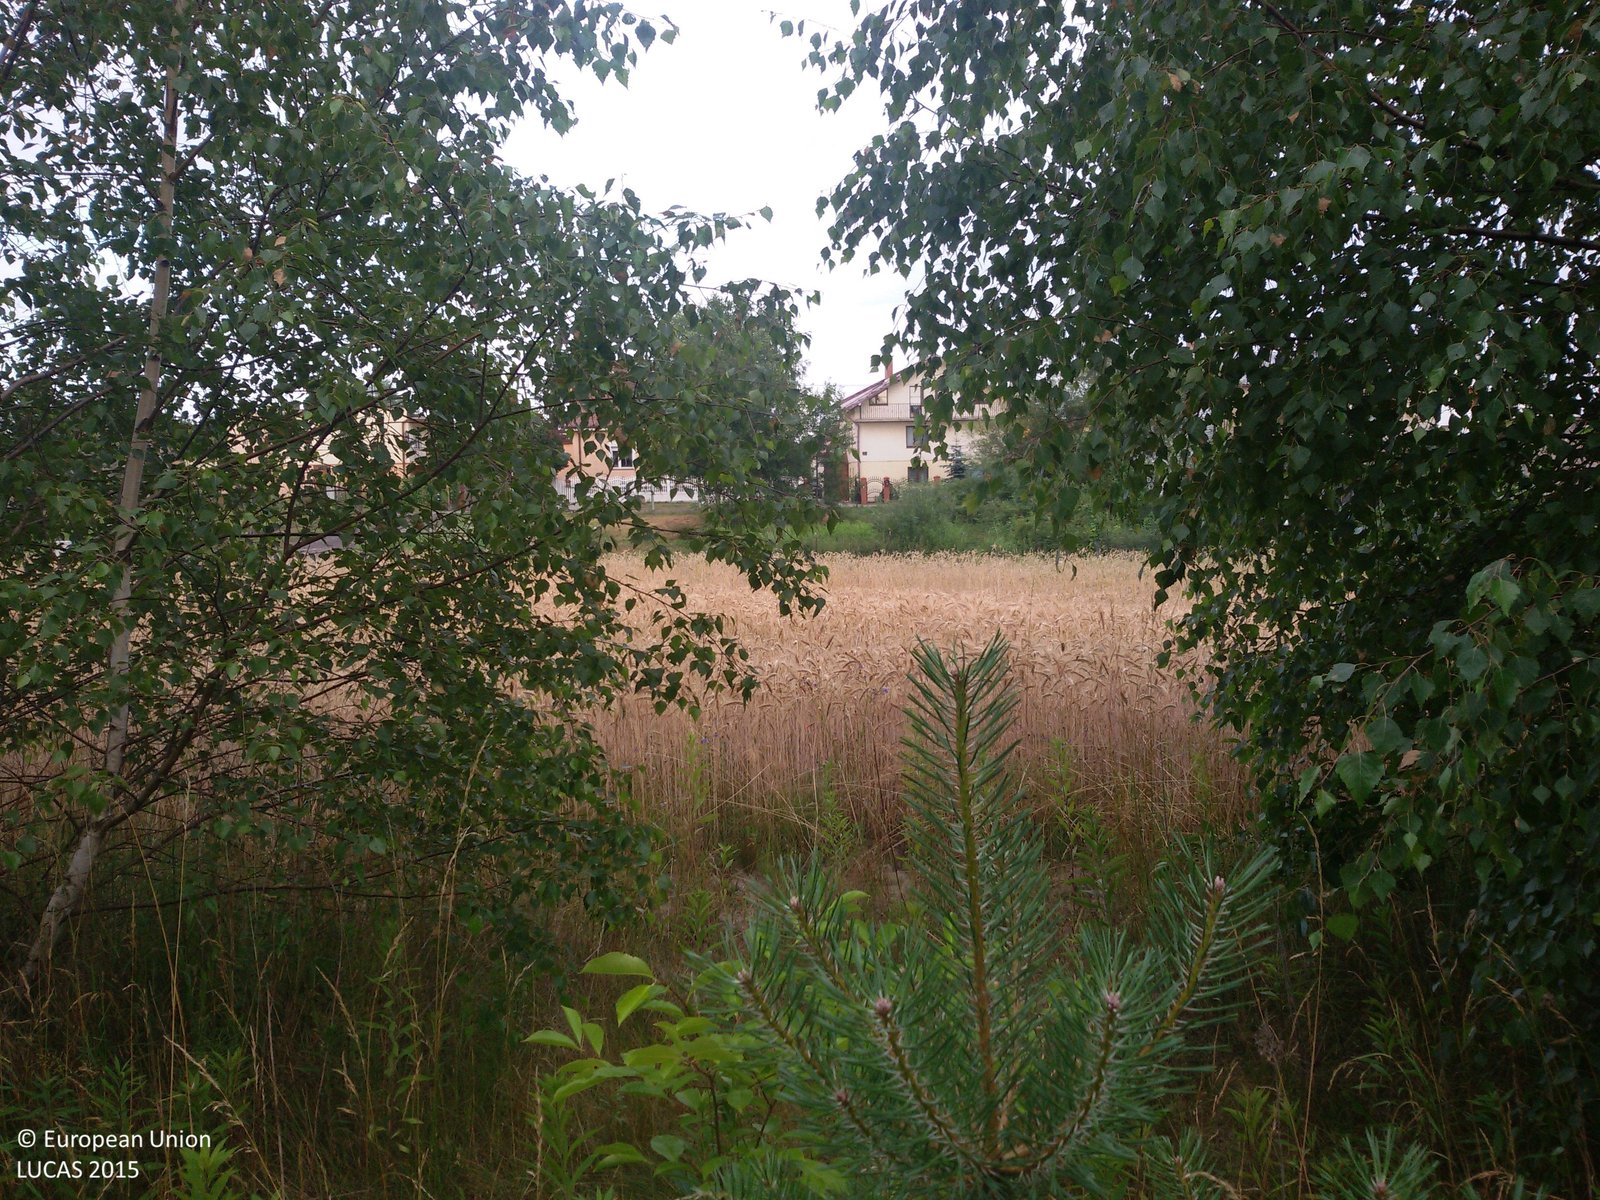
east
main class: Woodland
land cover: Broadleaved woodland
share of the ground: 10 - 25 %
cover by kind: herbaceous plants 85 %, broadleaved forest trees 15 %
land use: Semi-natural and natural areas not in use
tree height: > 5 m
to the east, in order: Broadleaved woodland; Triticale; Electric lines; Triticale; Artificial constructions in urban areas
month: July
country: PL
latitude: 52.7329
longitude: 19.1019
